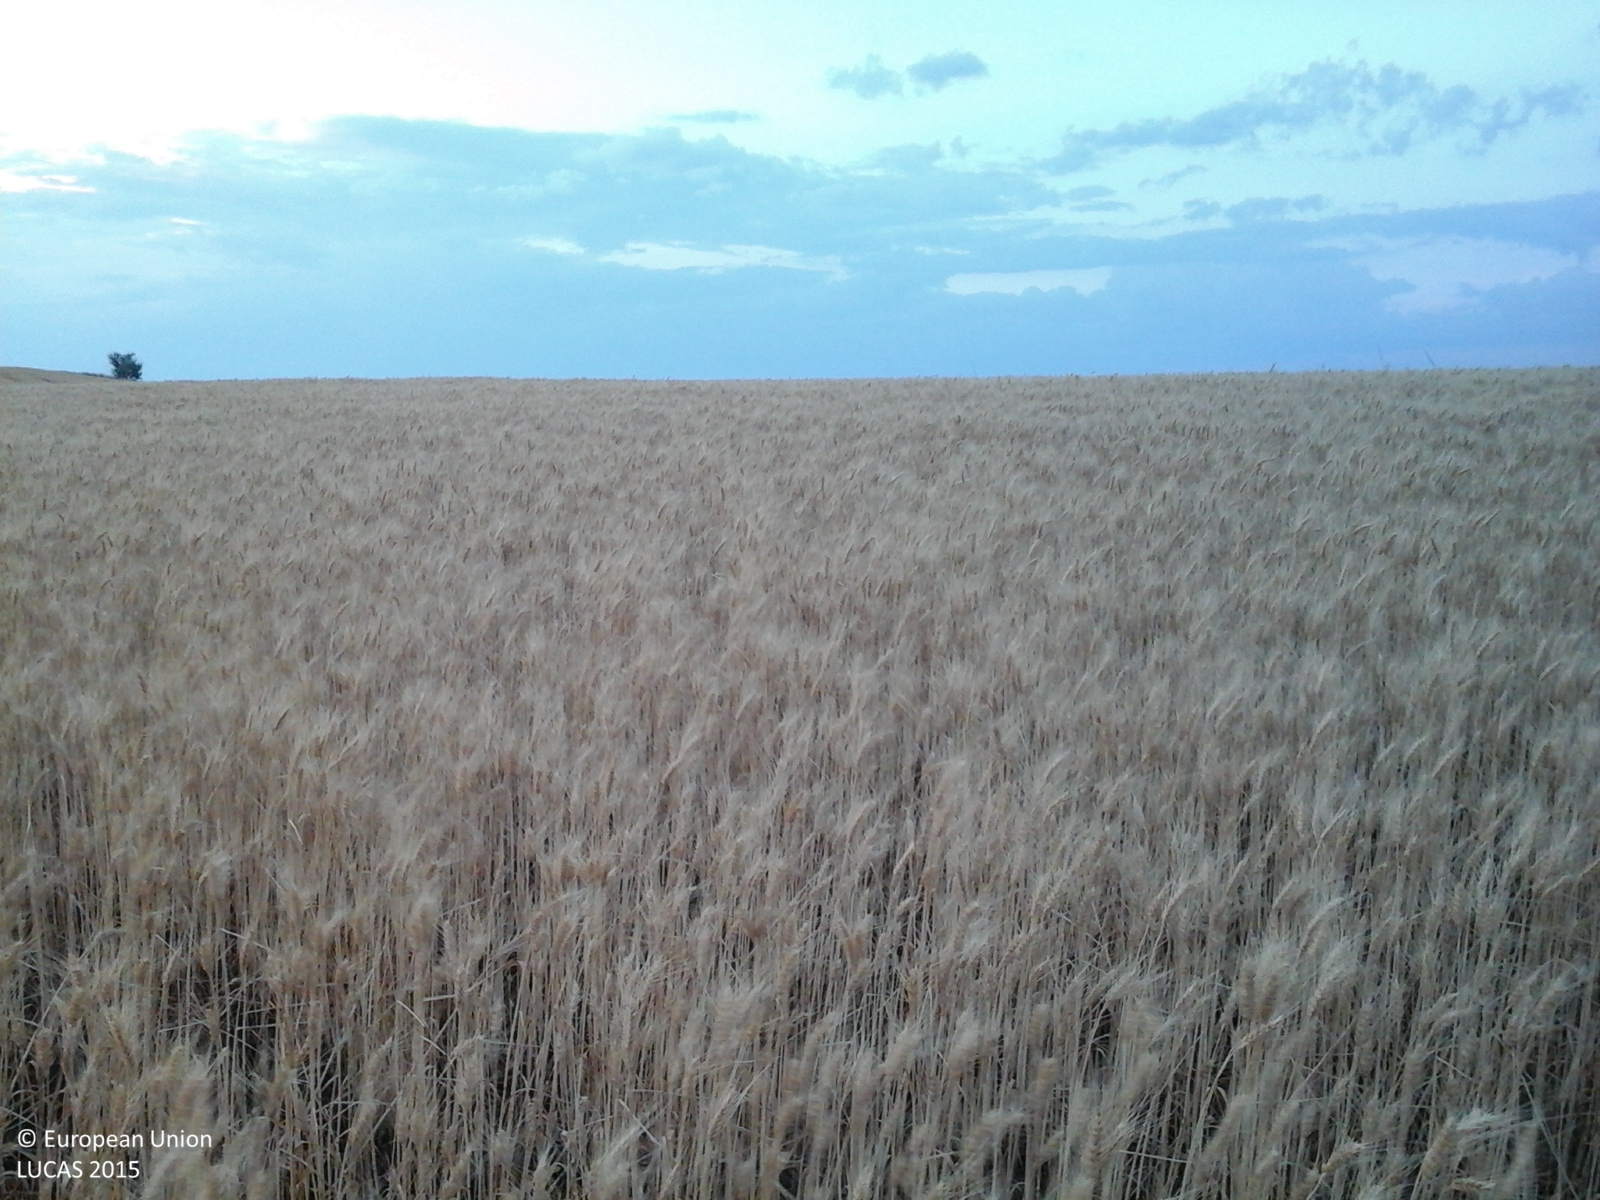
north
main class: Cropland
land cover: Common wheat
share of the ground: > 75 %
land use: Agriculture (excluding fallow land and kitchen gardens)
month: June
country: RO
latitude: 46.7880
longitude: 28.0641
